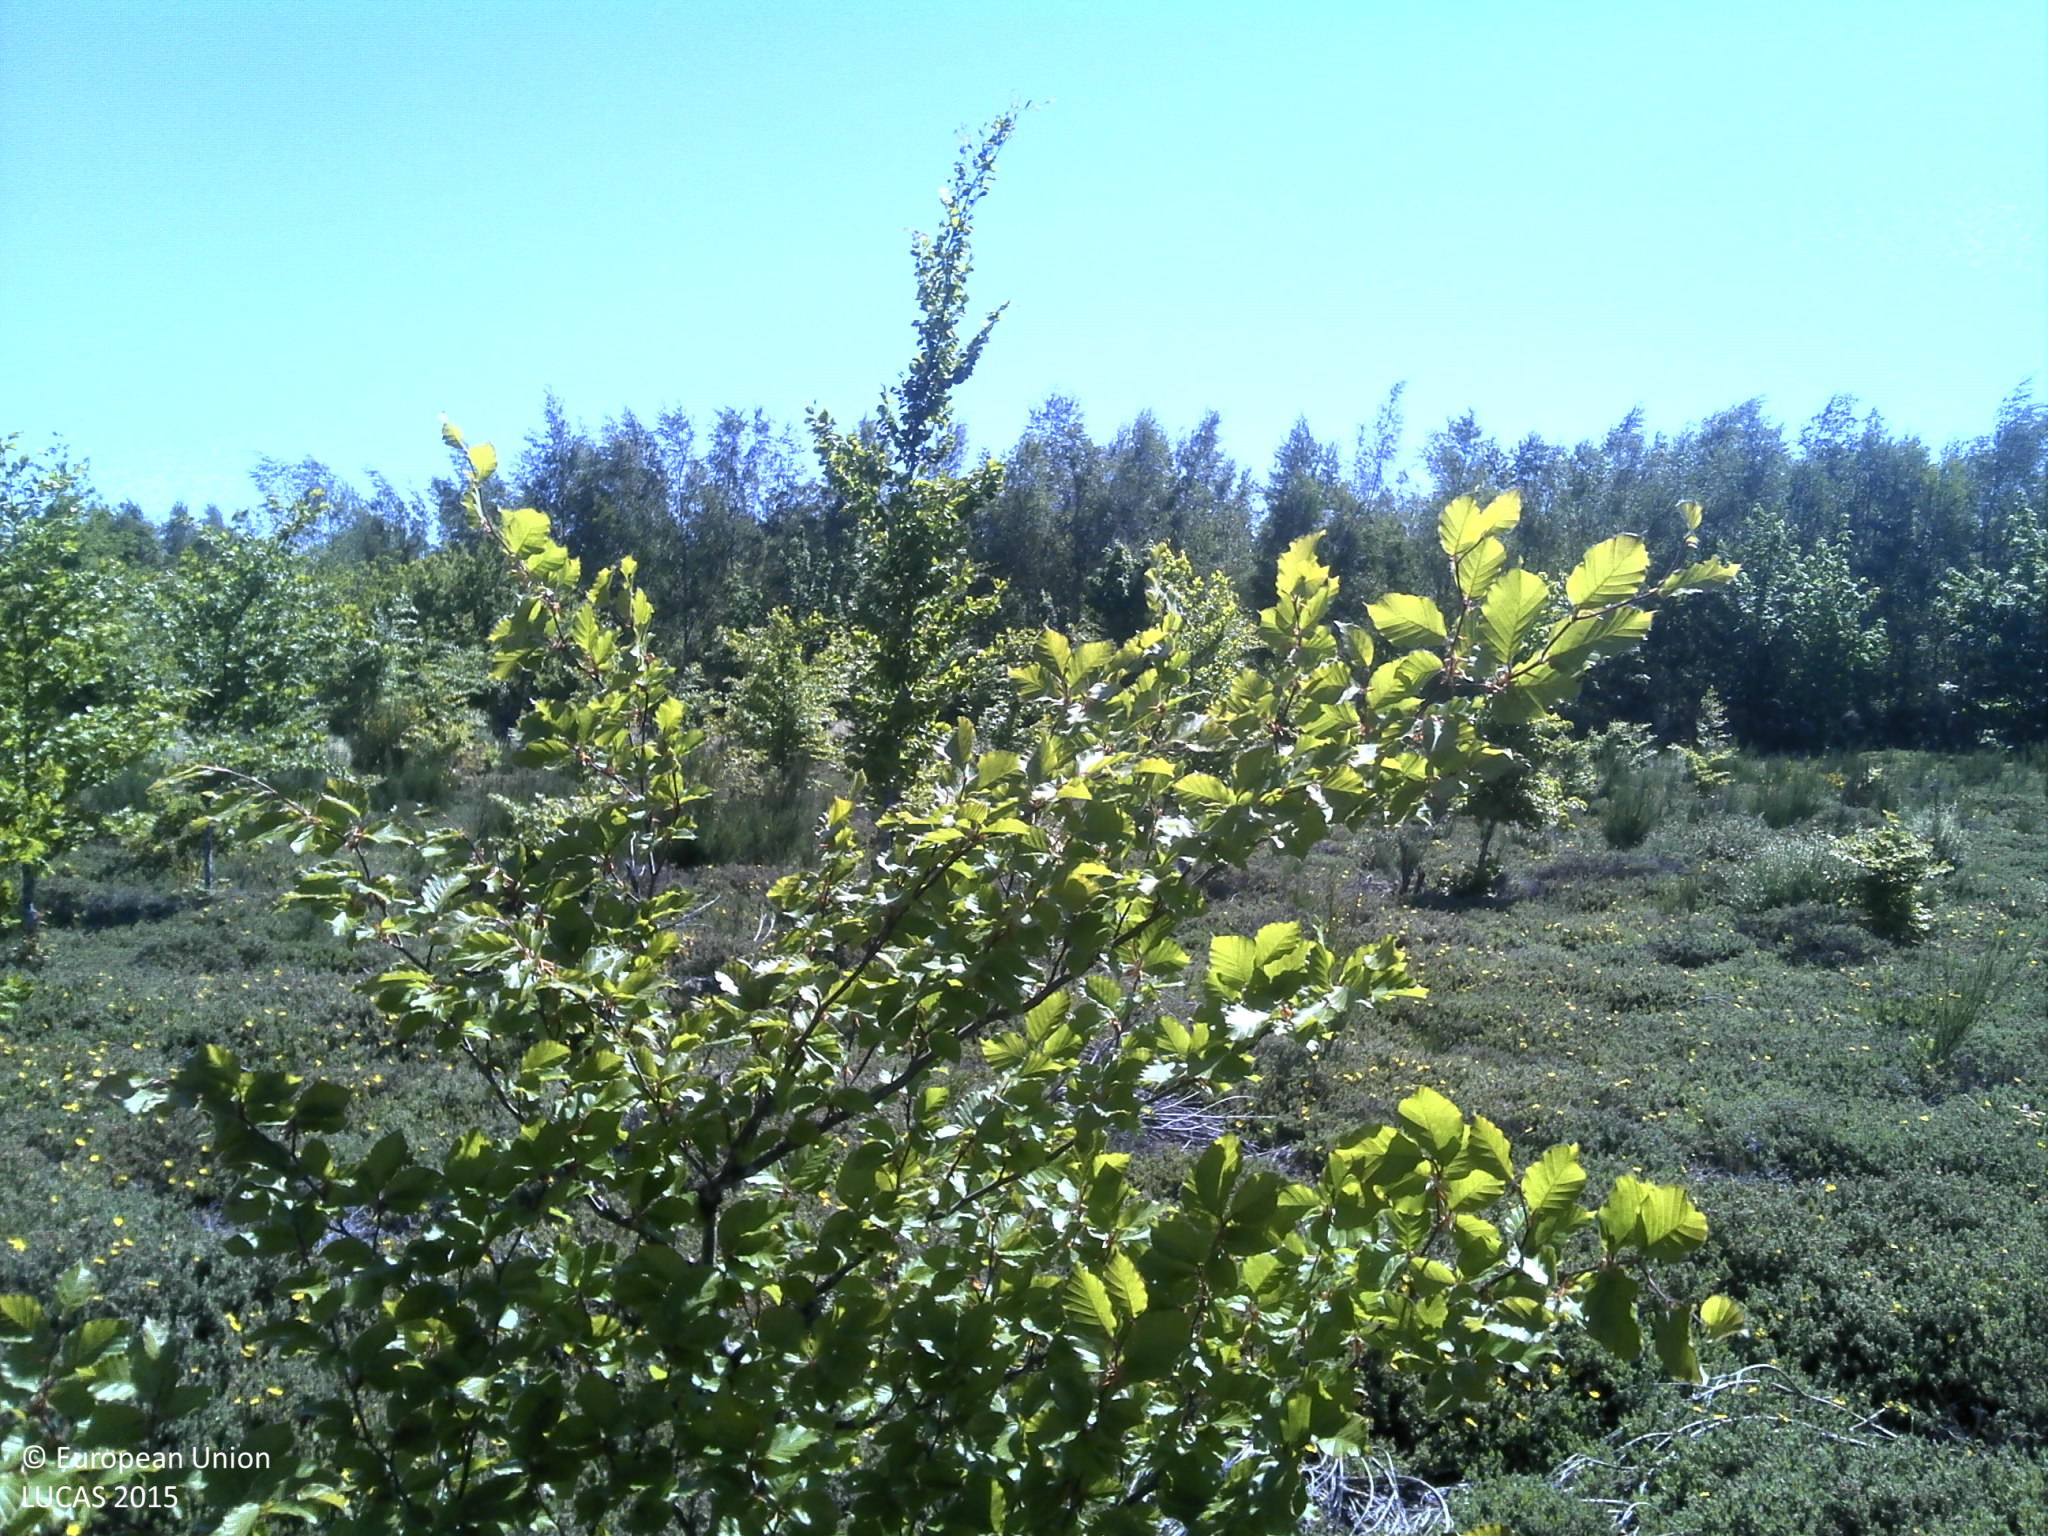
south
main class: Woodland
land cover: Broadleaved woodland
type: mesophytic deciduous forest
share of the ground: 25 - 50 %
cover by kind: broadleaved forest trees 45 %, shrubs 25 %, herbaceous plants 25 %
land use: Forestry
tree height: > 5 m
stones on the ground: 10 - 25 %
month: May
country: PT
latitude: 40.5212
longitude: -7.4252
